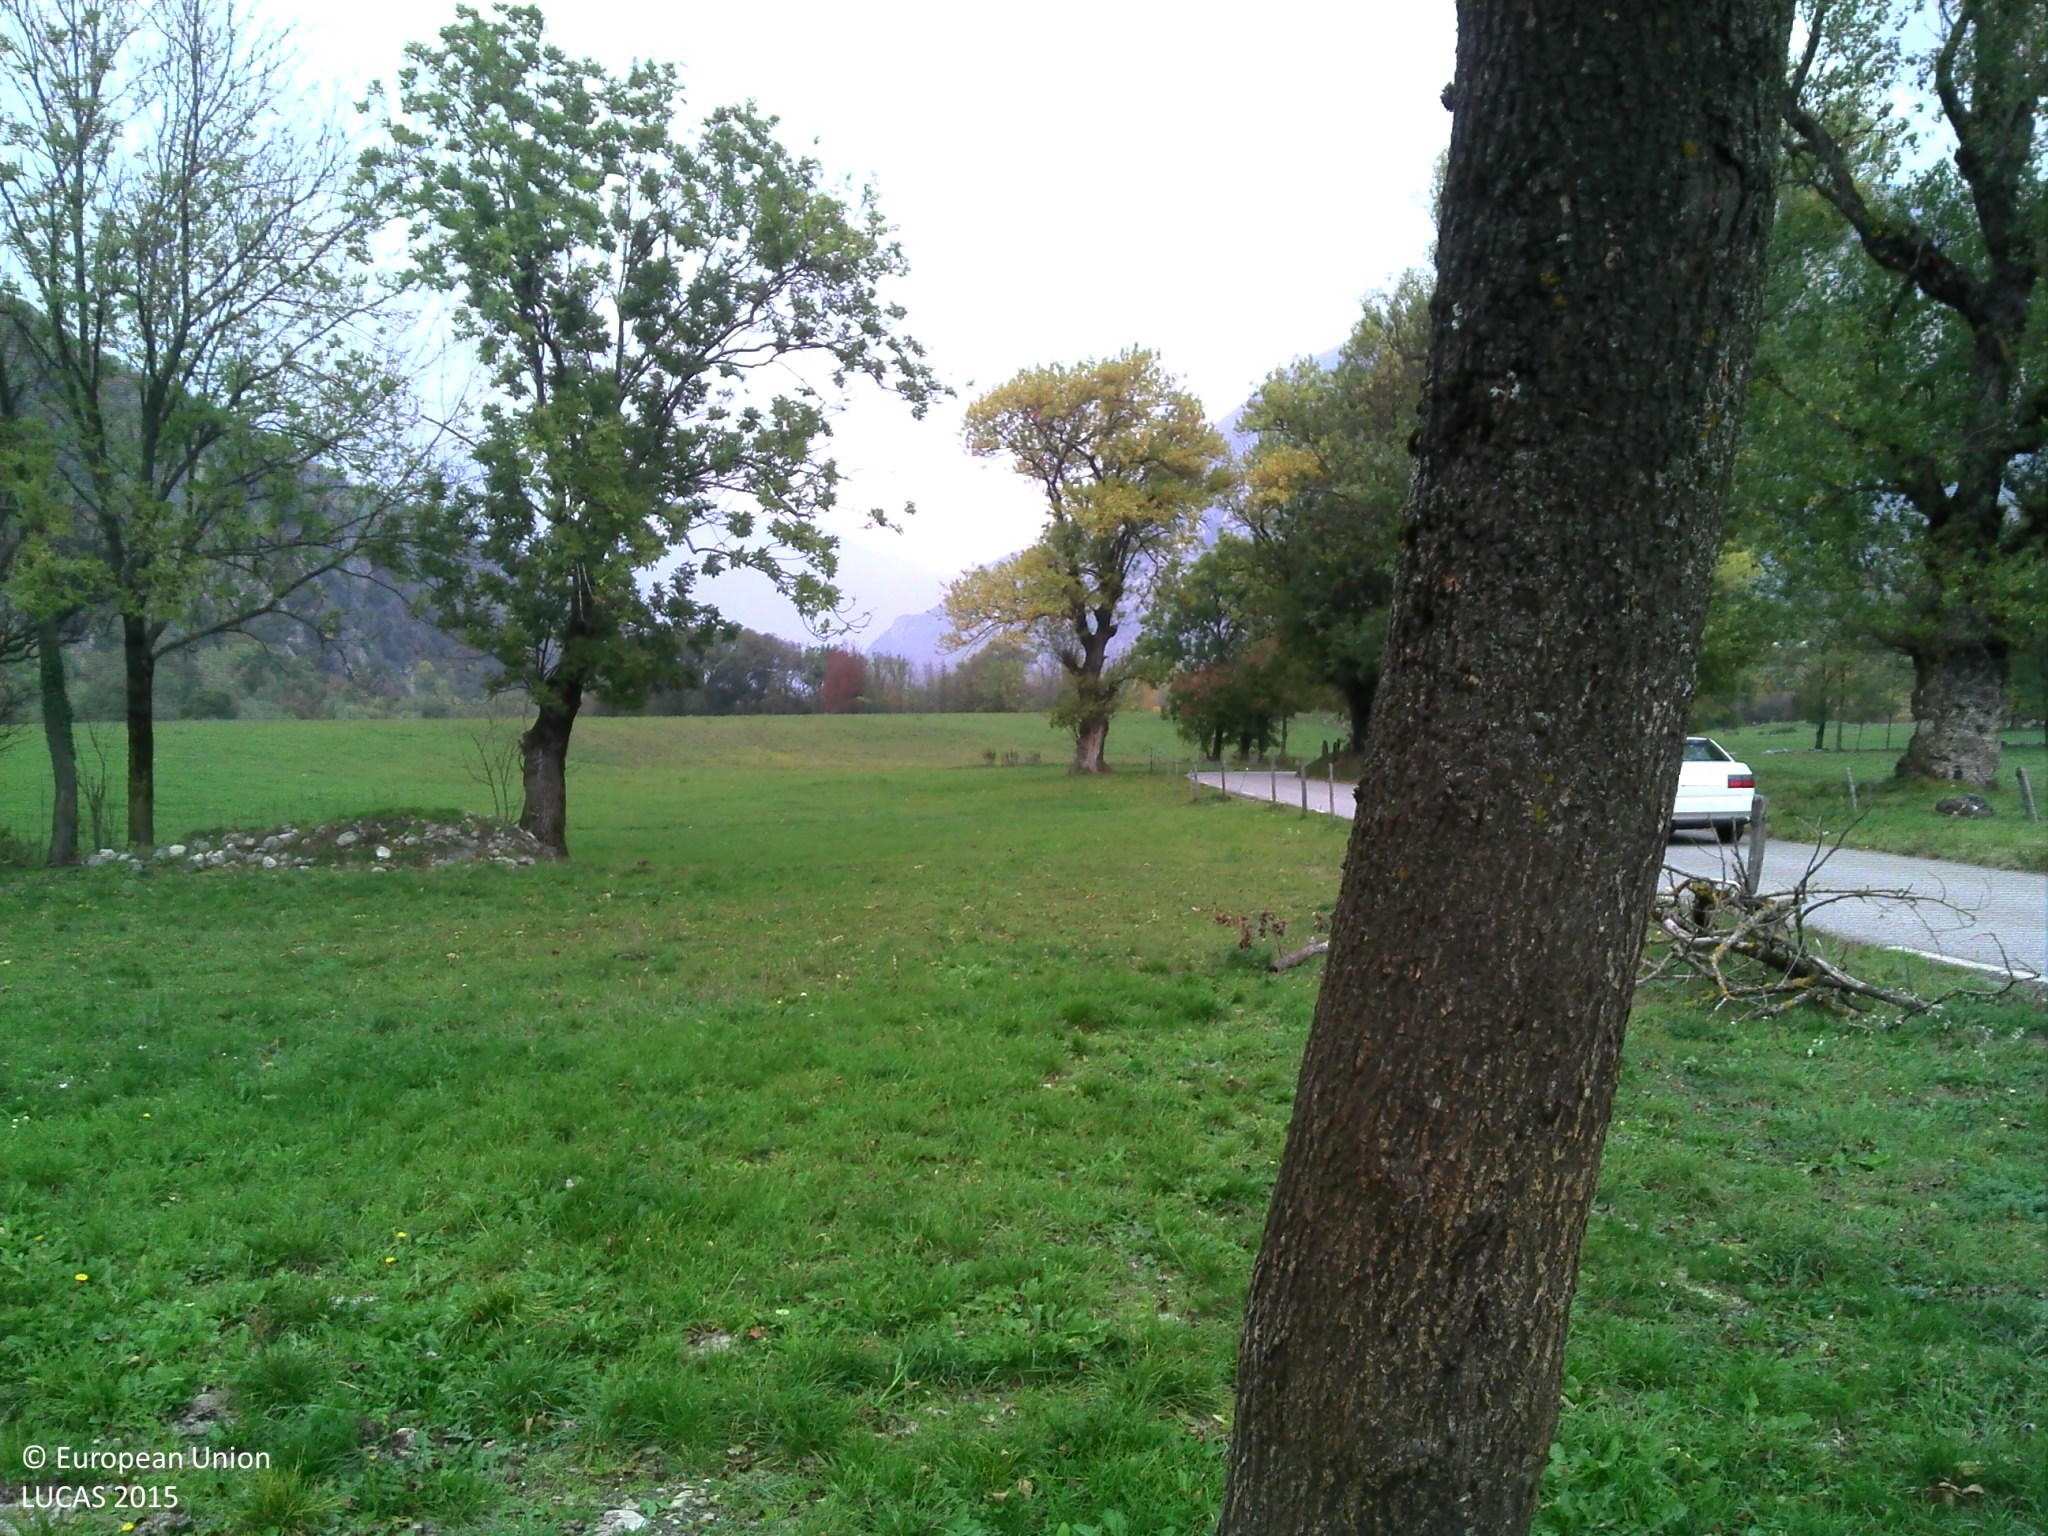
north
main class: Grassland
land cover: Grassland with sparse tree/shrub cover
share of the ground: > 75 %
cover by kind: herbaceous plants 90 %, broadleaved forest trees 5 %, consolidated bare surface 5 %
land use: Agriculture (excluding fallow land and kitchen gardens)
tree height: > 5 m
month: October
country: FR
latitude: 45.3491
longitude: 6.2907
